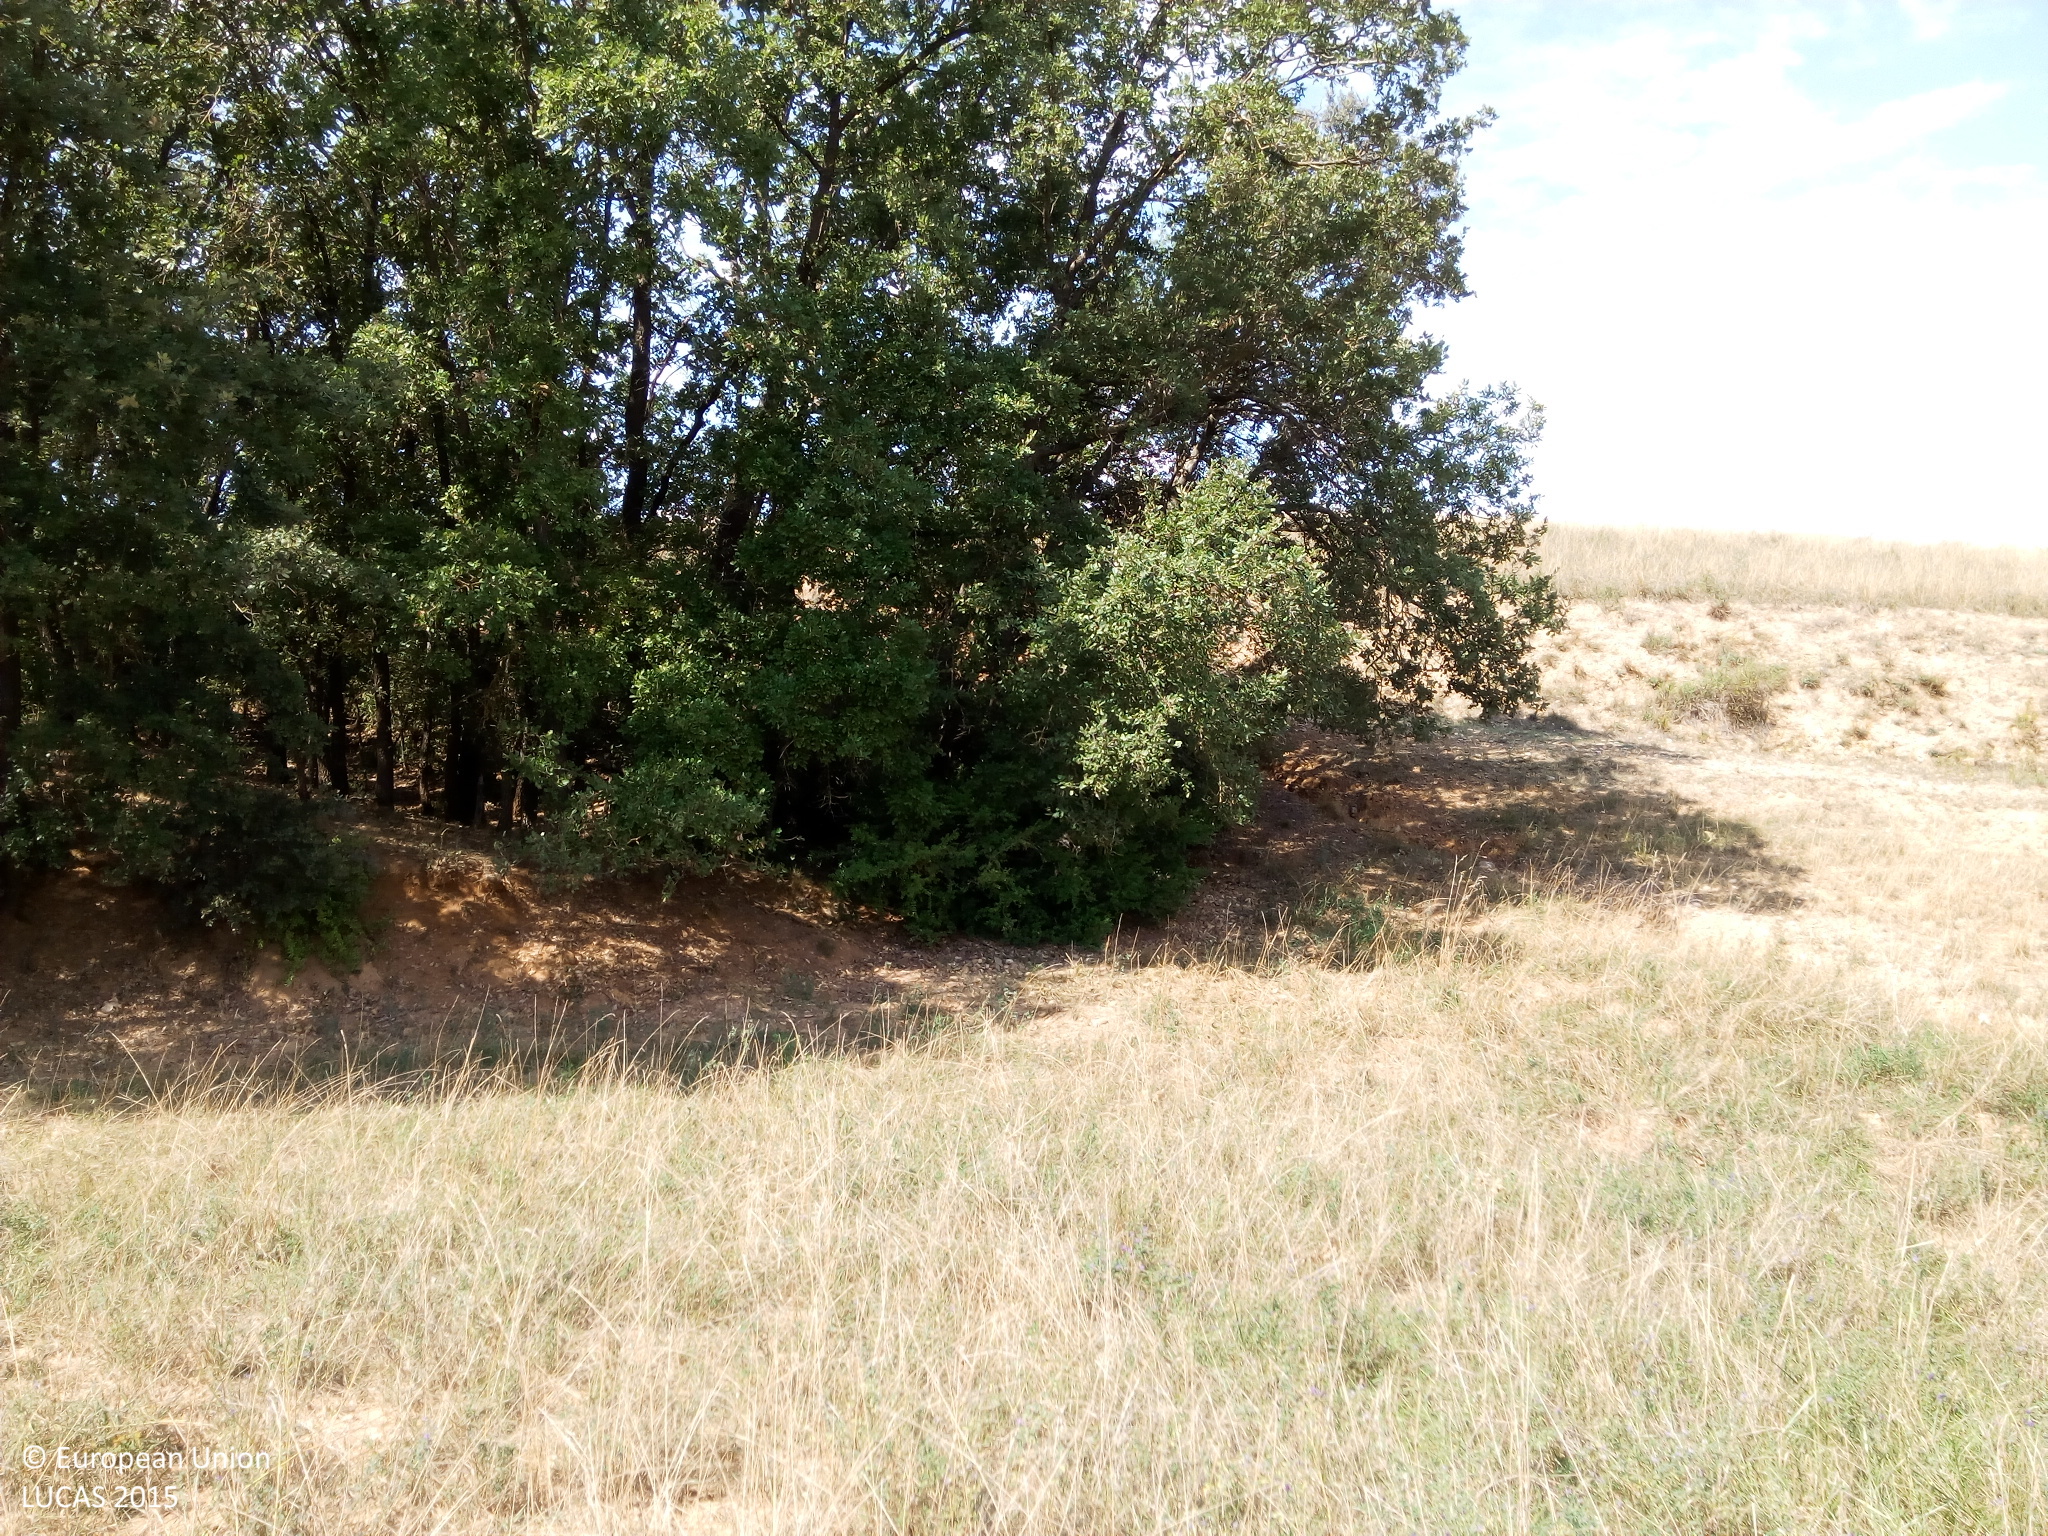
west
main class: Grassland
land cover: Grassland without tree/shrub cover
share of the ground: > 75 %
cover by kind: unconsolidated bare surface 60 %, herbaceous plants 40 %
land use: Agriculture (excluding fallow land and kitchen gardens)
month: August
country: ES
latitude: 42.0789
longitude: 0.4946
